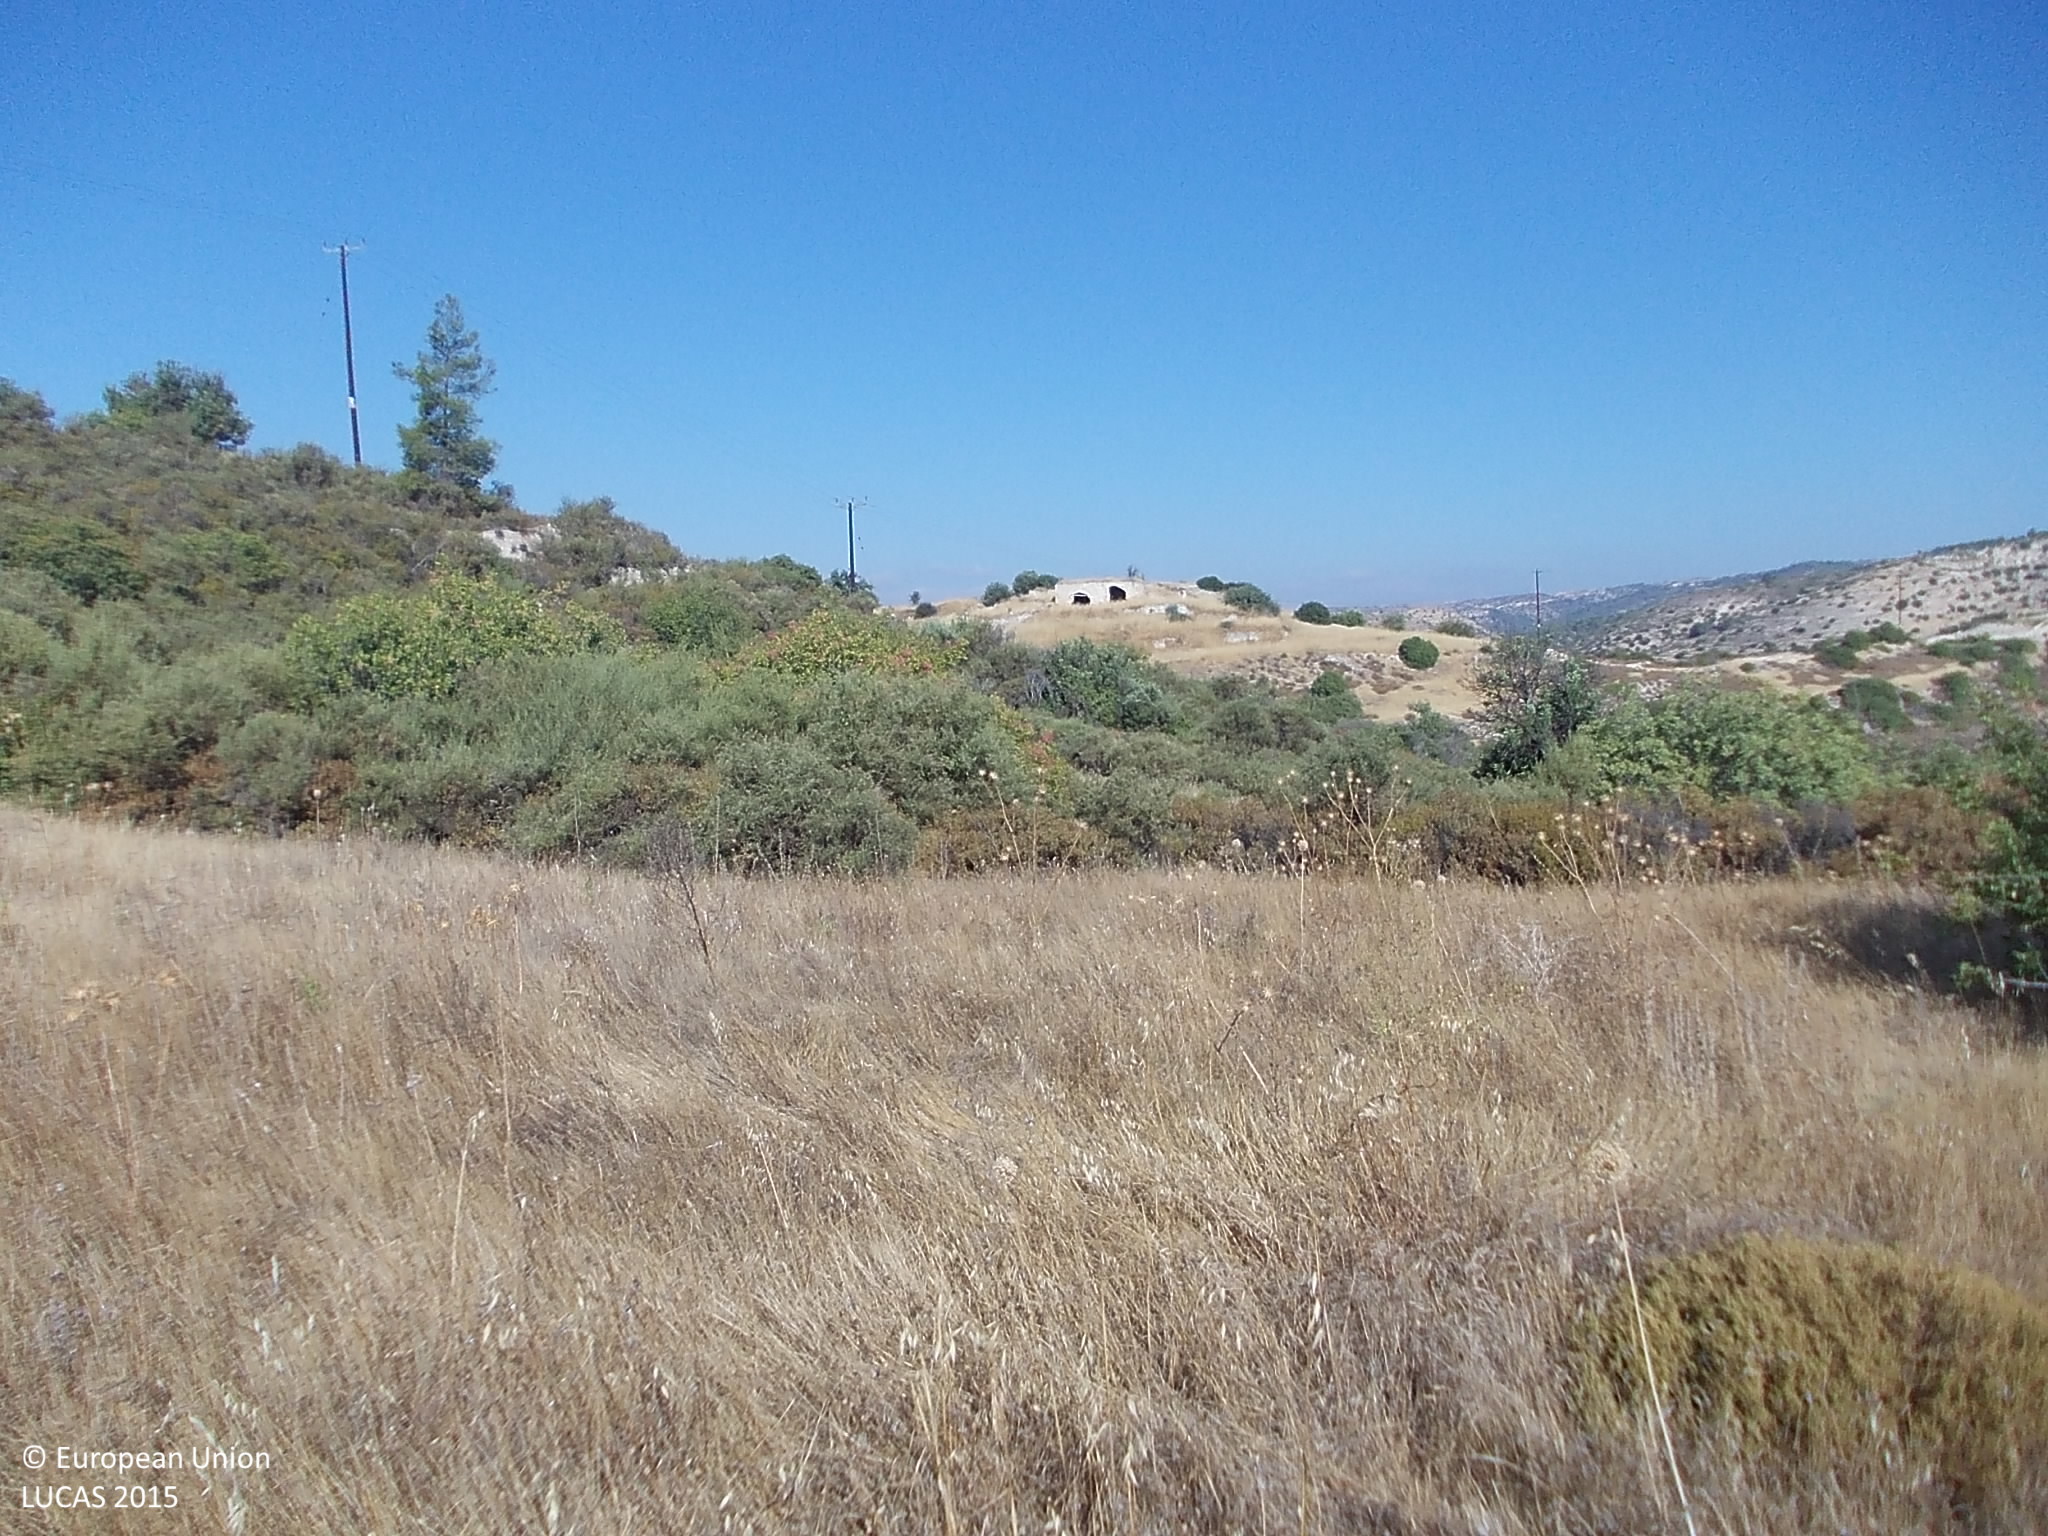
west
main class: Grassland
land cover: Grassland with sparse tree/shrub cover
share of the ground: > 75 %
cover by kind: herbaceous plants 90 %, coniferous forest trees 5 %, shrubs 5 %
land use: Semi-natural and natural areas not in use
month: August
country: CY
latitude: 34.7638
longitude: 32.8979
